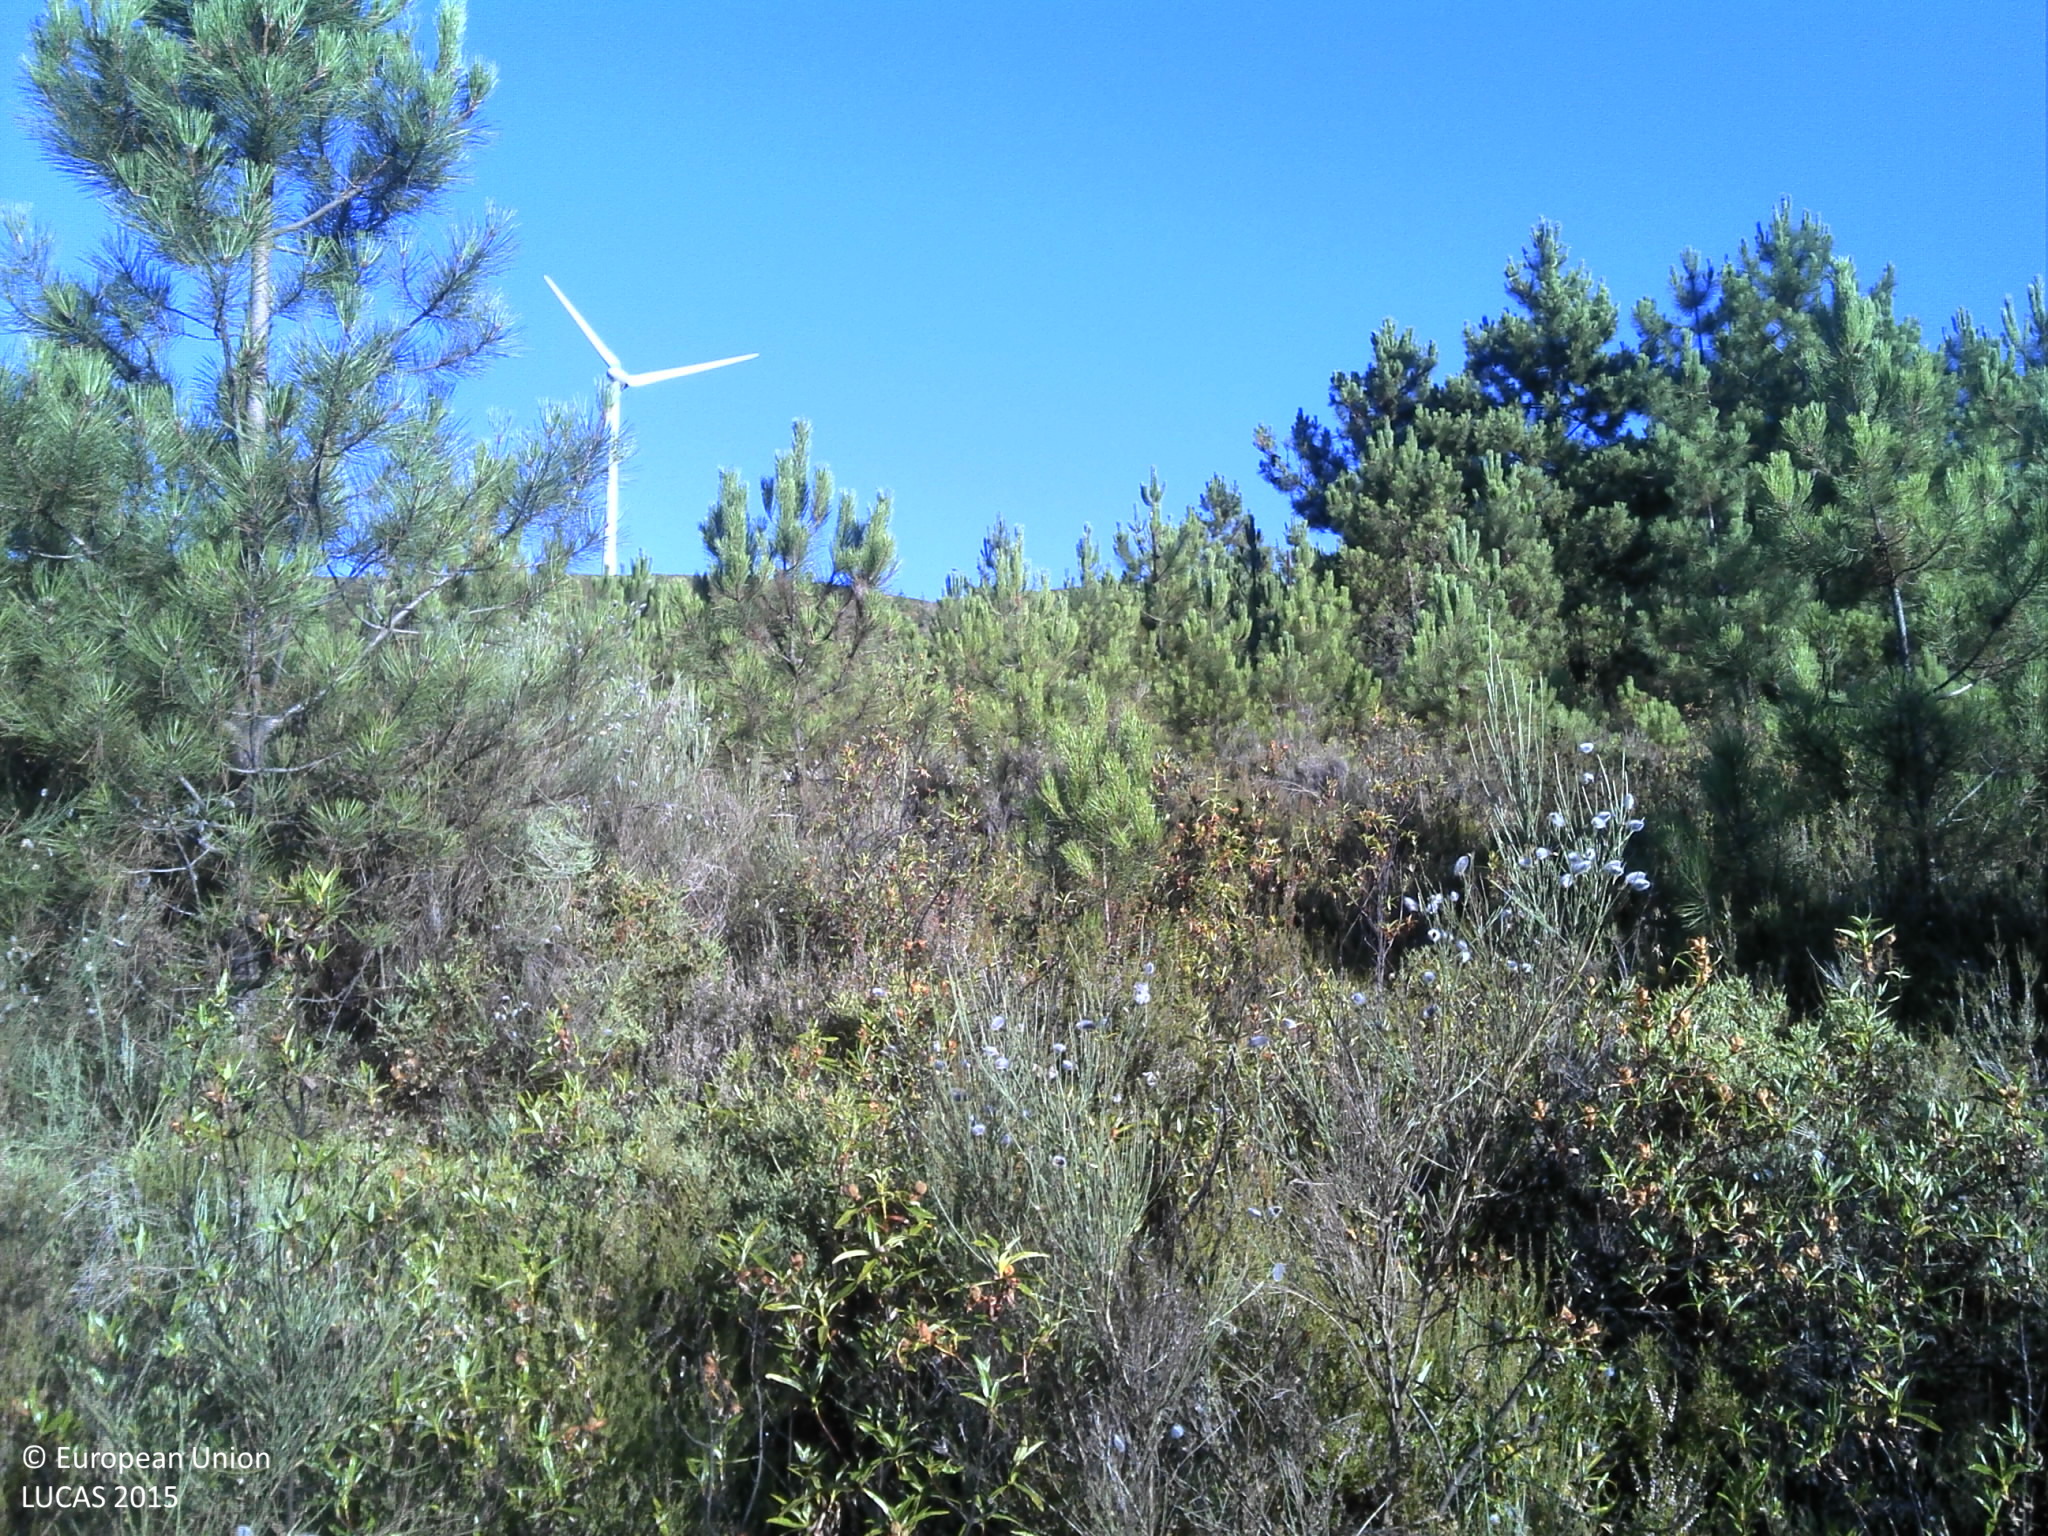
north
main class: Shrubland
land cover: Shrubland without tree cover
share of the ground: 50 - 75 %
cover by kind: shrubs 65 %, unconsolidated bare surface 35 %
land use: Forestry
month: July
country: PT
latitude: 40.0943
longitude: -7.6430
